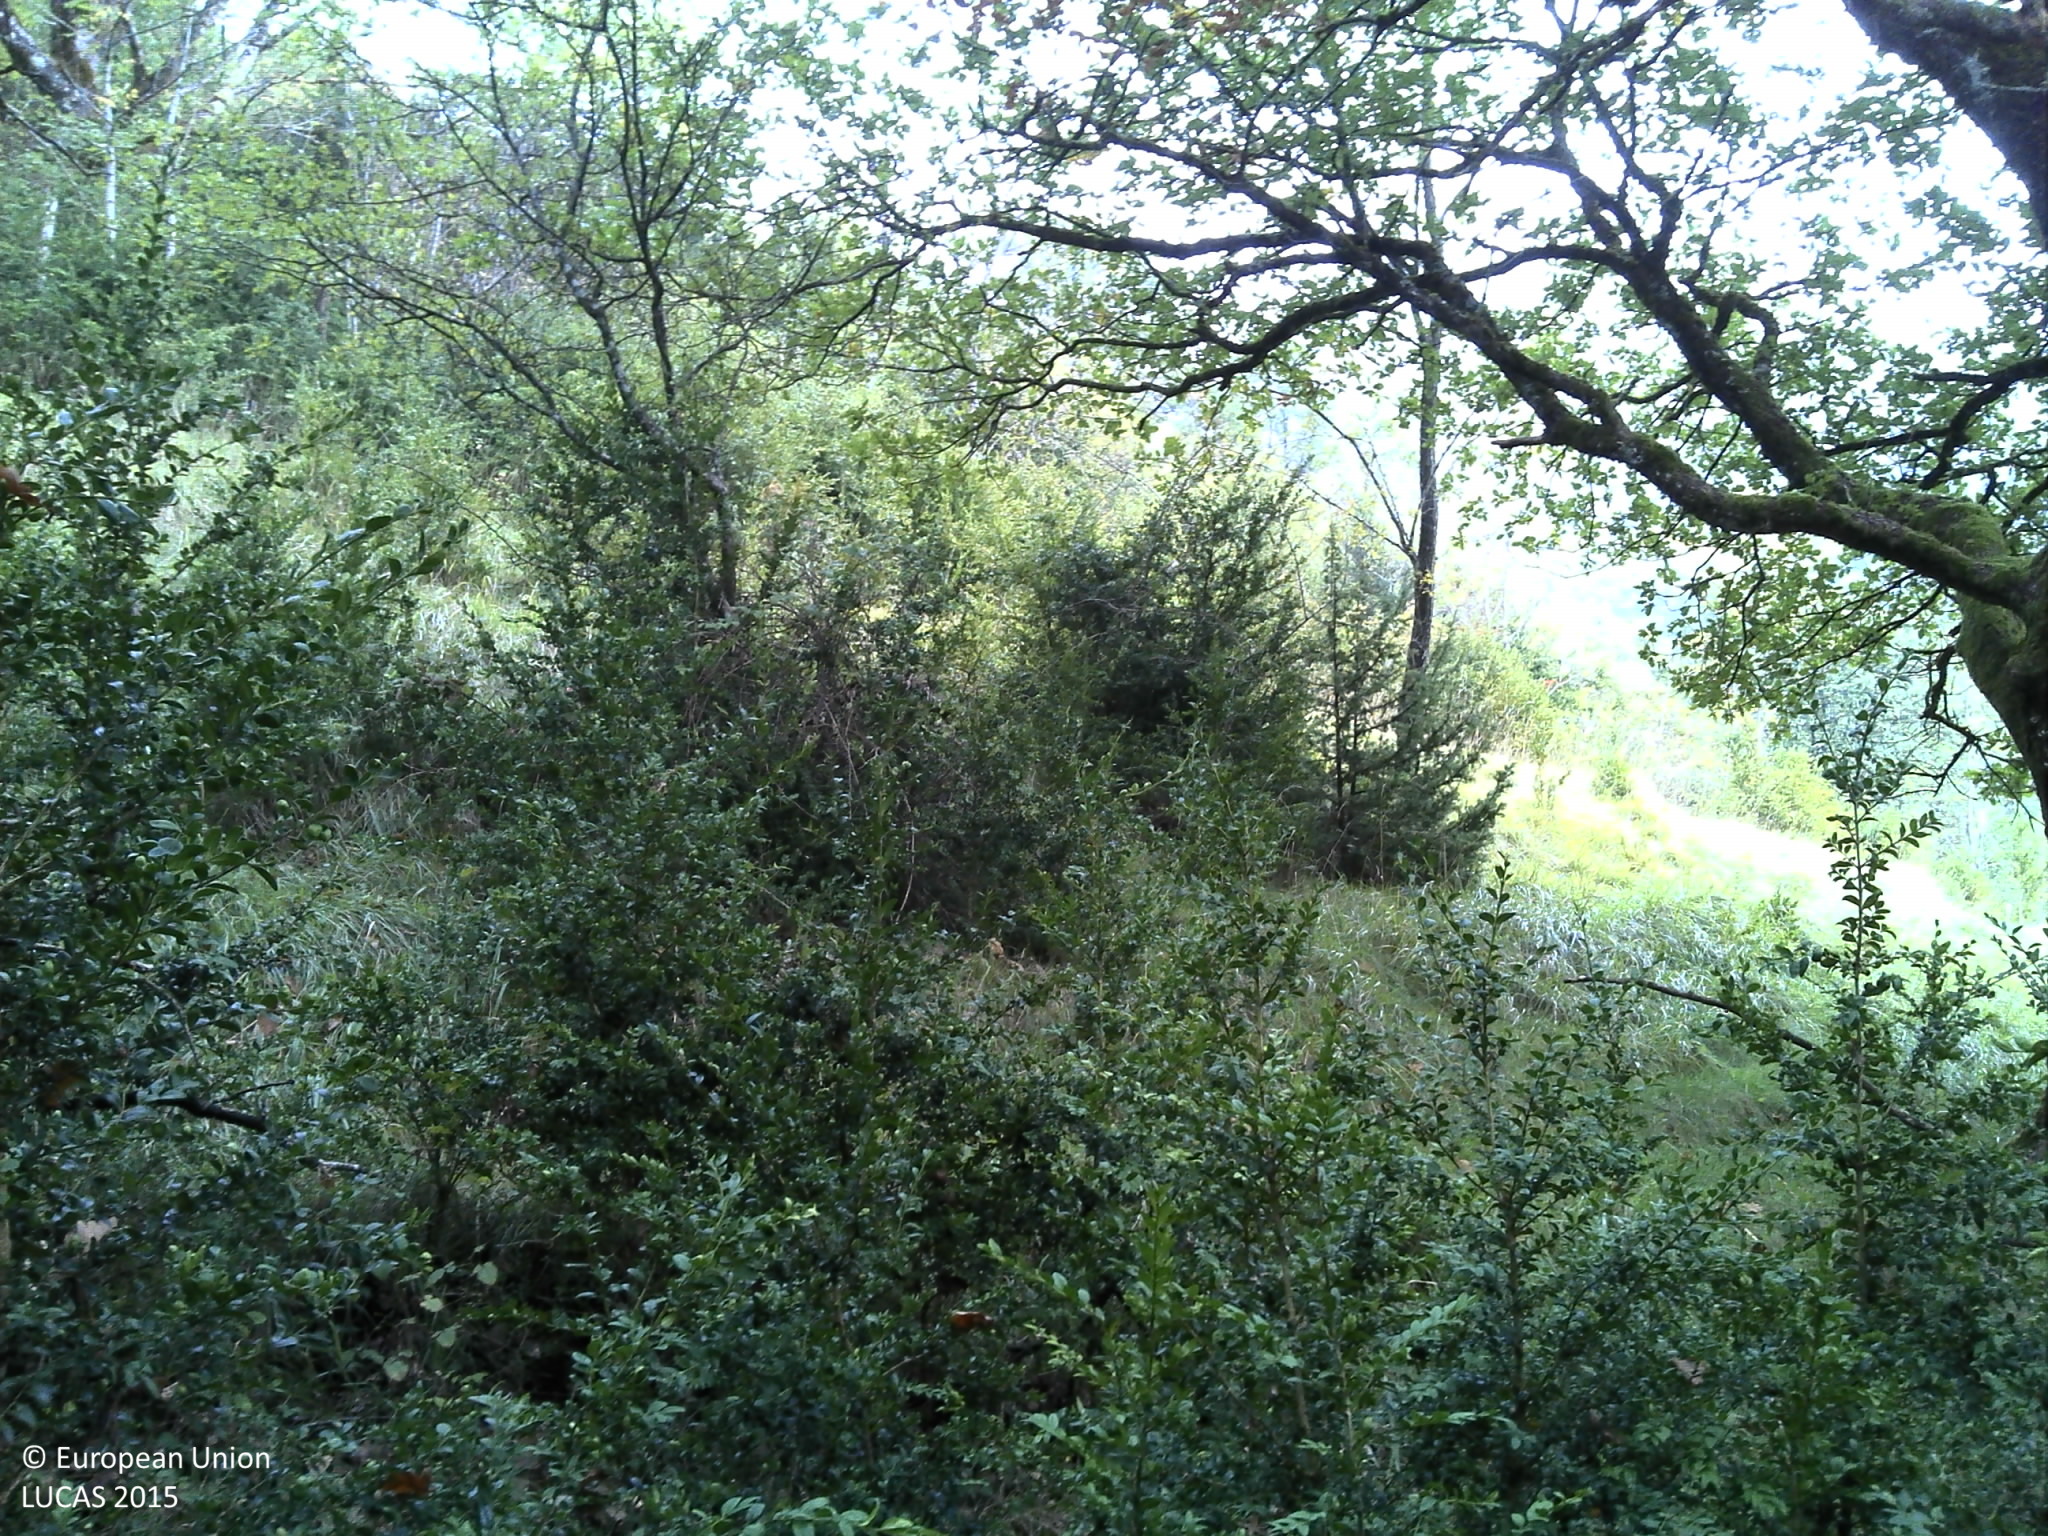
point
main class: Woodland
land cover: Broadleaved woodland
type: acidophilous oak and oak-birch forest
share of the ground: 50 - 75 %
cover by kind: broadleaved forest trees 50 %, herbaceous plants 30 %, shrubs 20 %
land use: Forestry
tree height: > 5 m
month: October
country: FR
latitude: 46.3241
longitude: 5.3920
